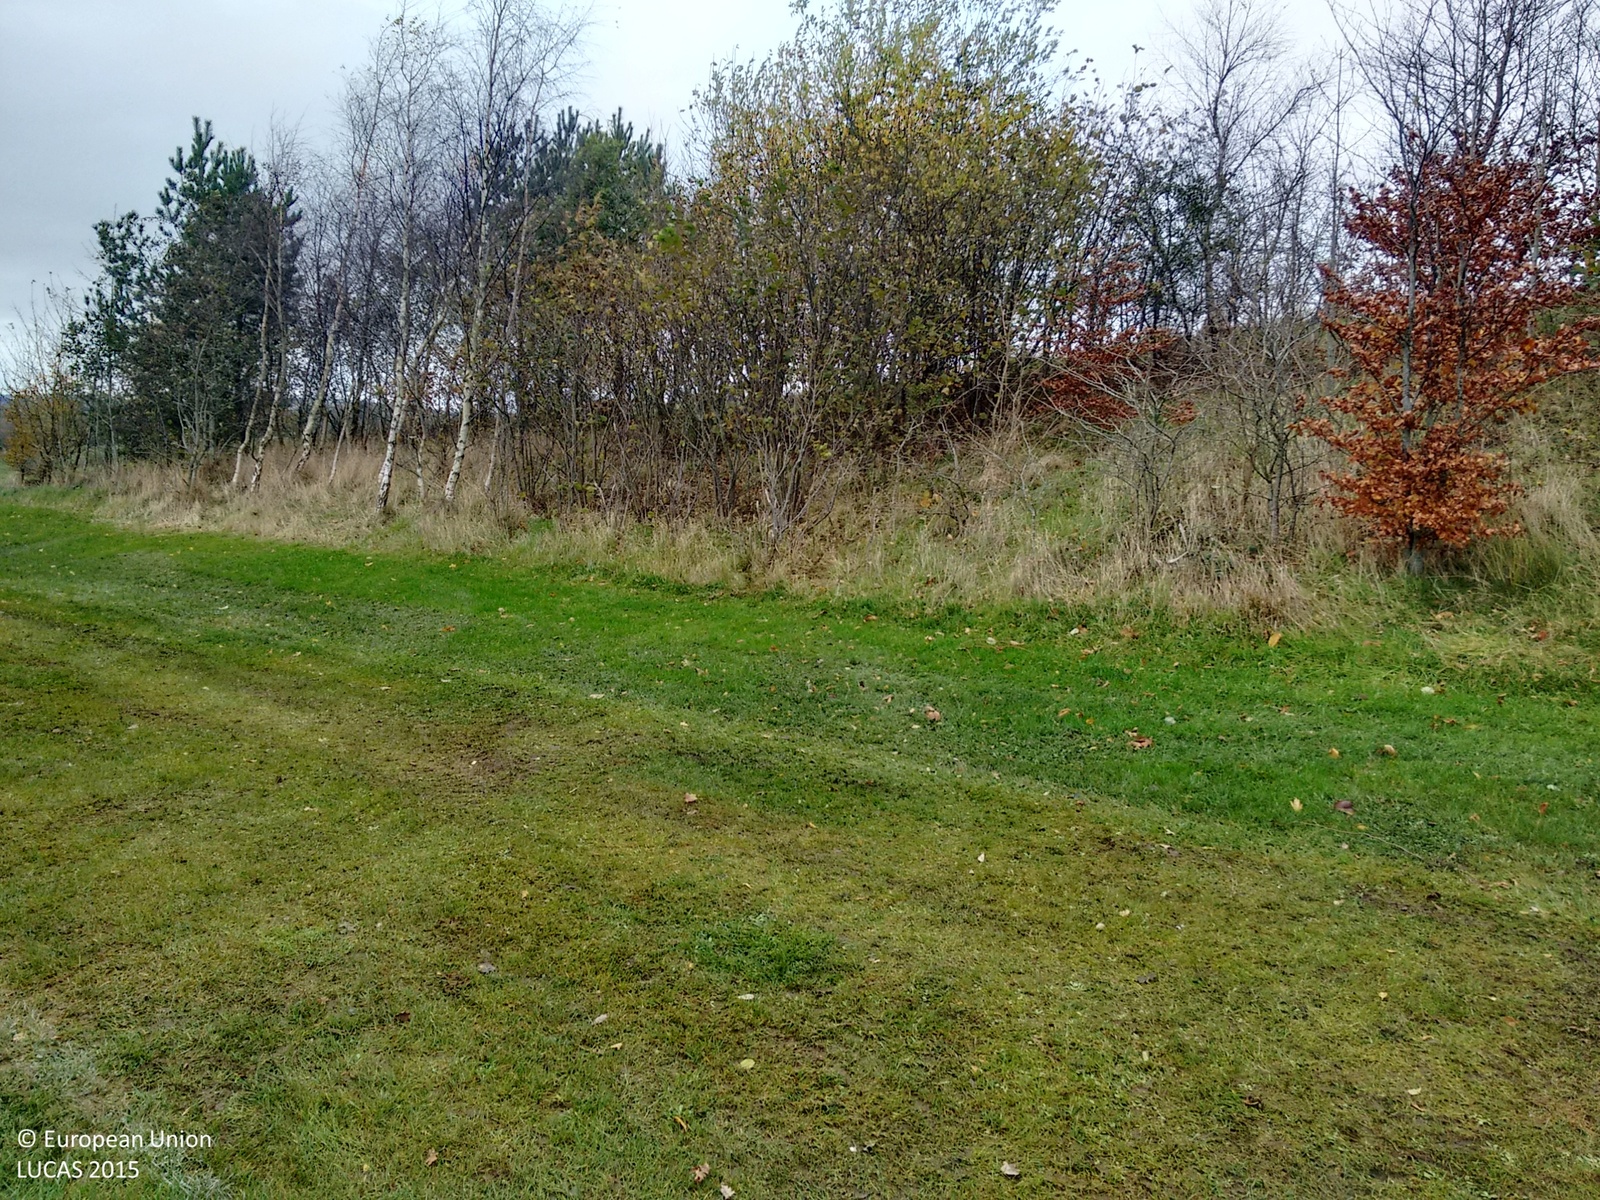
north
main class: Grassland
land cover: Grassland without tree/shrub cover
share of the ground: > 75 %
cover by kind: herbaceous plants 100 %
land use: Sport
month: November
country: GB
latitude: 54.5785
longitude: -5.7758
